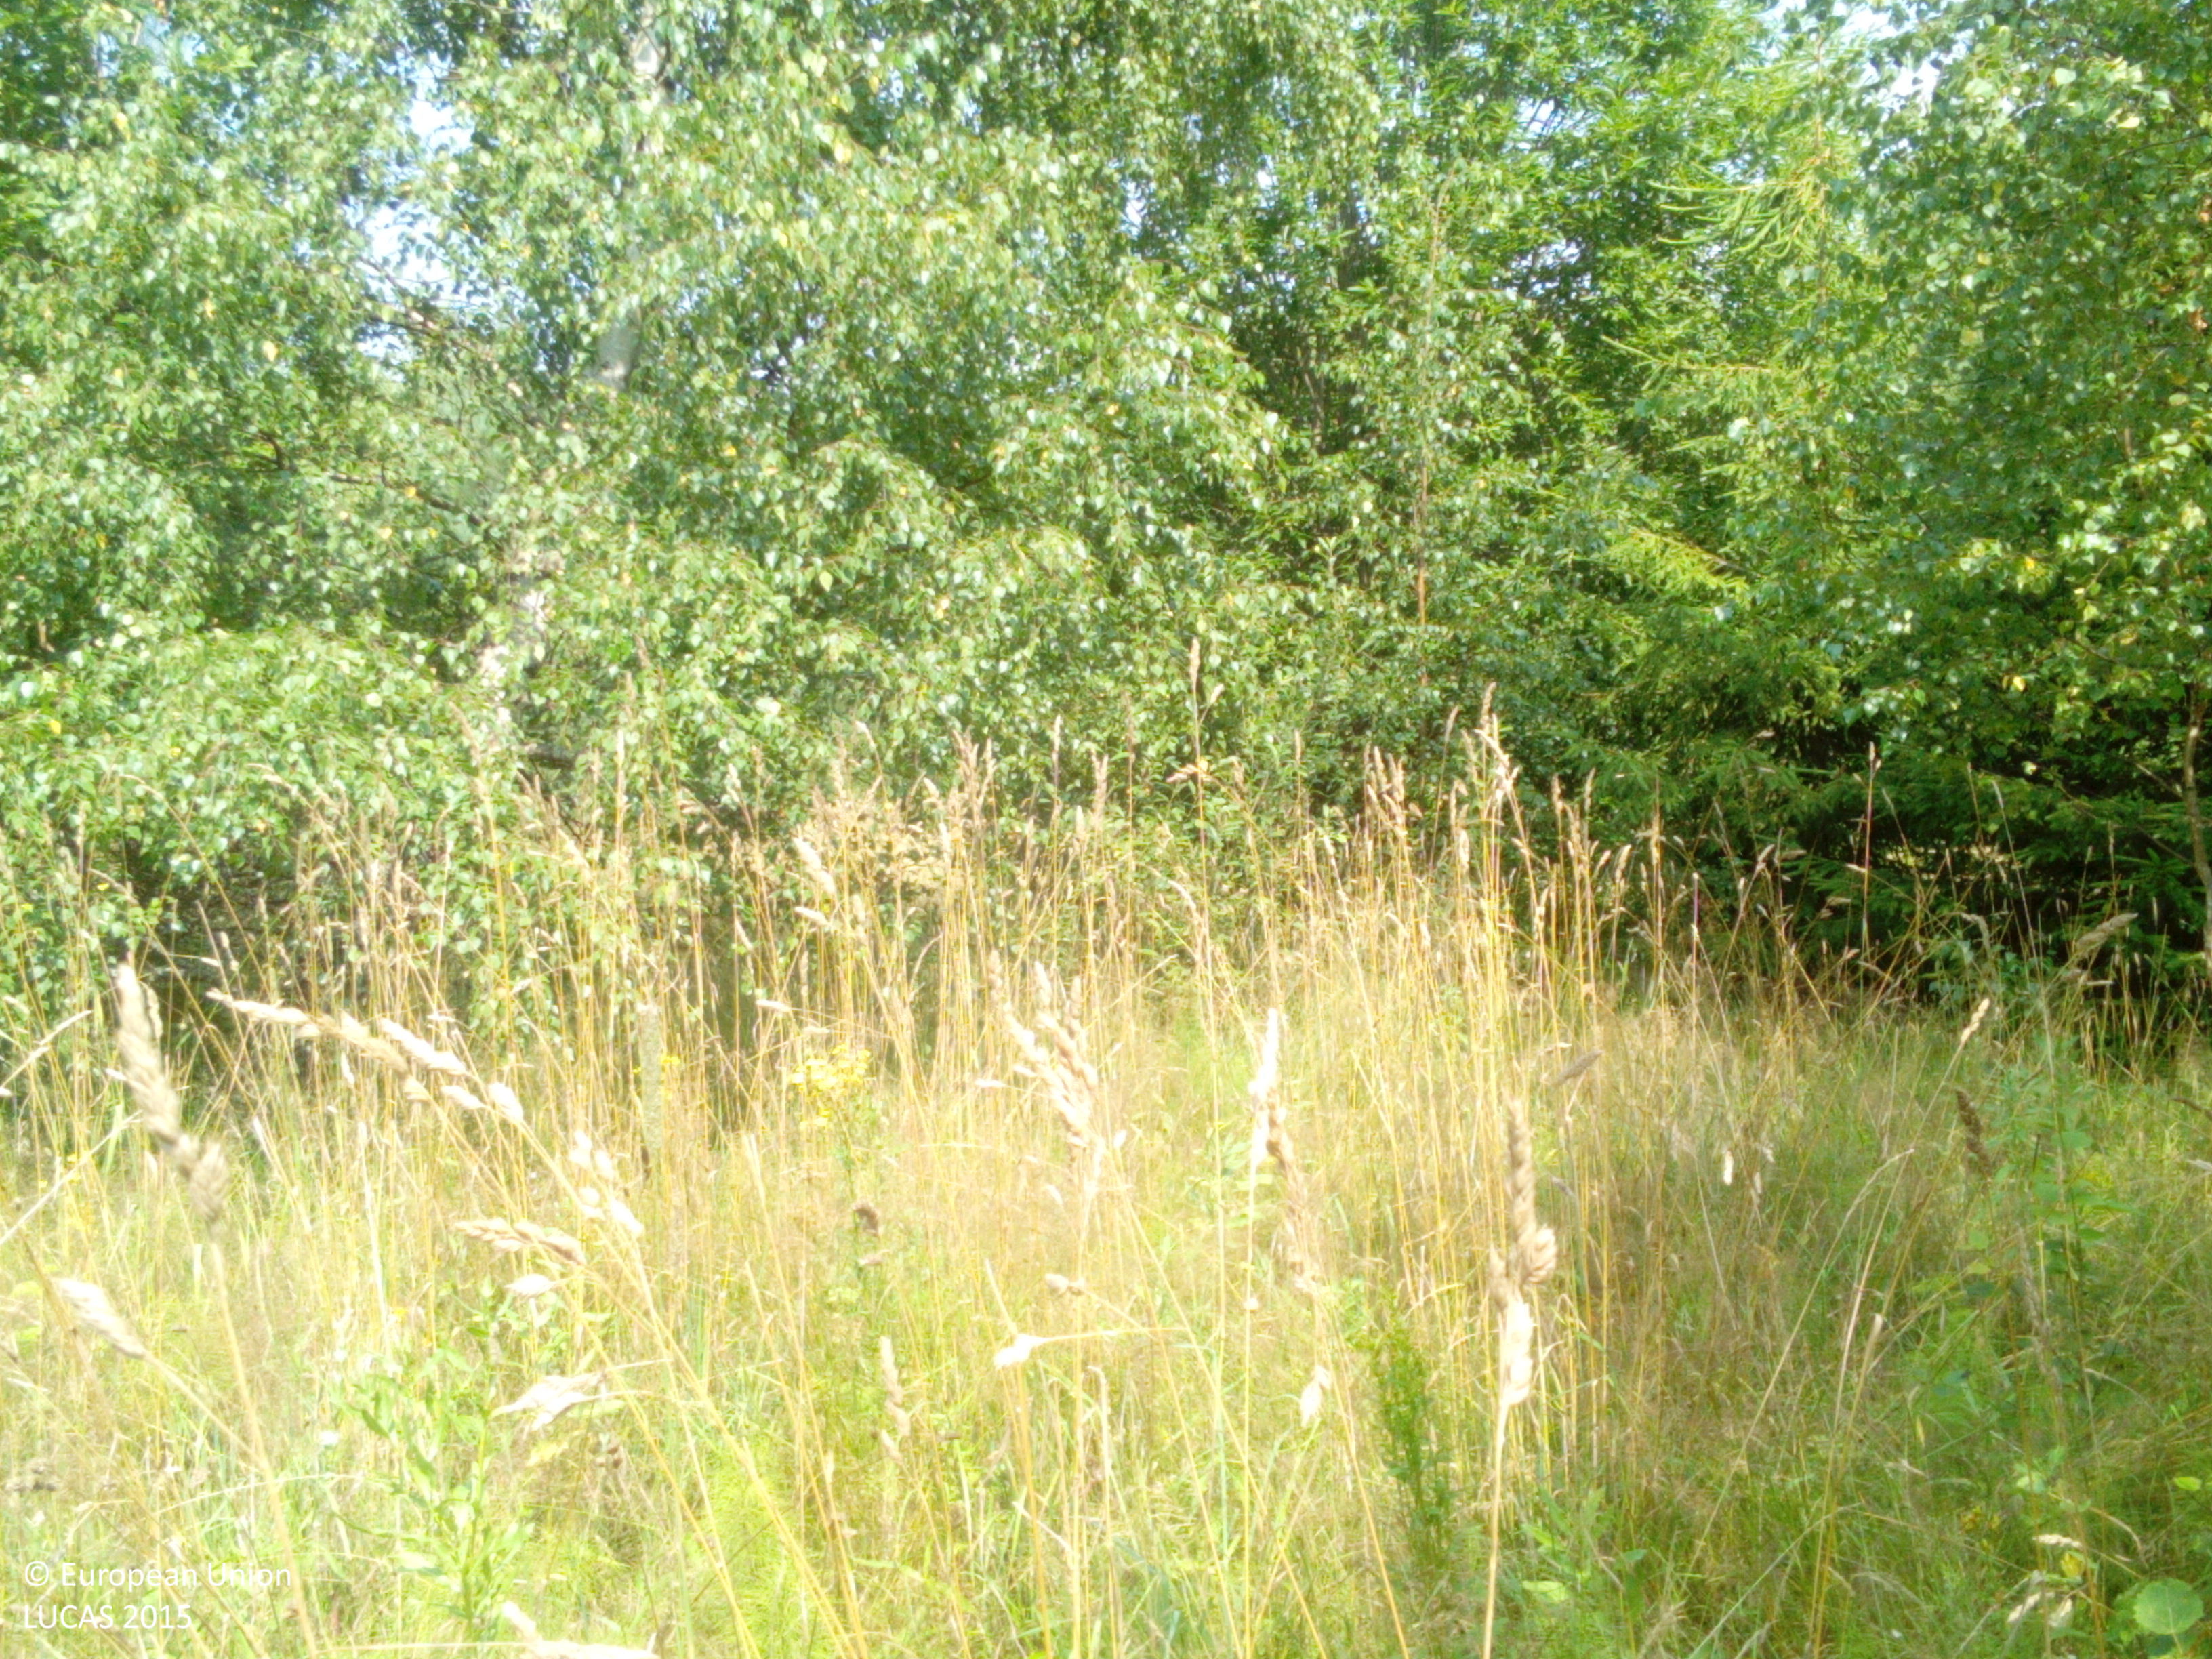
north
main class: Woodland
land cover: Pine dominated mixed woodland
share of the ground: 50 - 75 %
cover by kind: herbaceous plants 50 %, coniferous forest trees 25 %, broadleaved forest trees 25 %
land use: Forestry
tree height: > 5 m
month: August
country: LV
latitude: 56.9364
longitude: 21.7620
